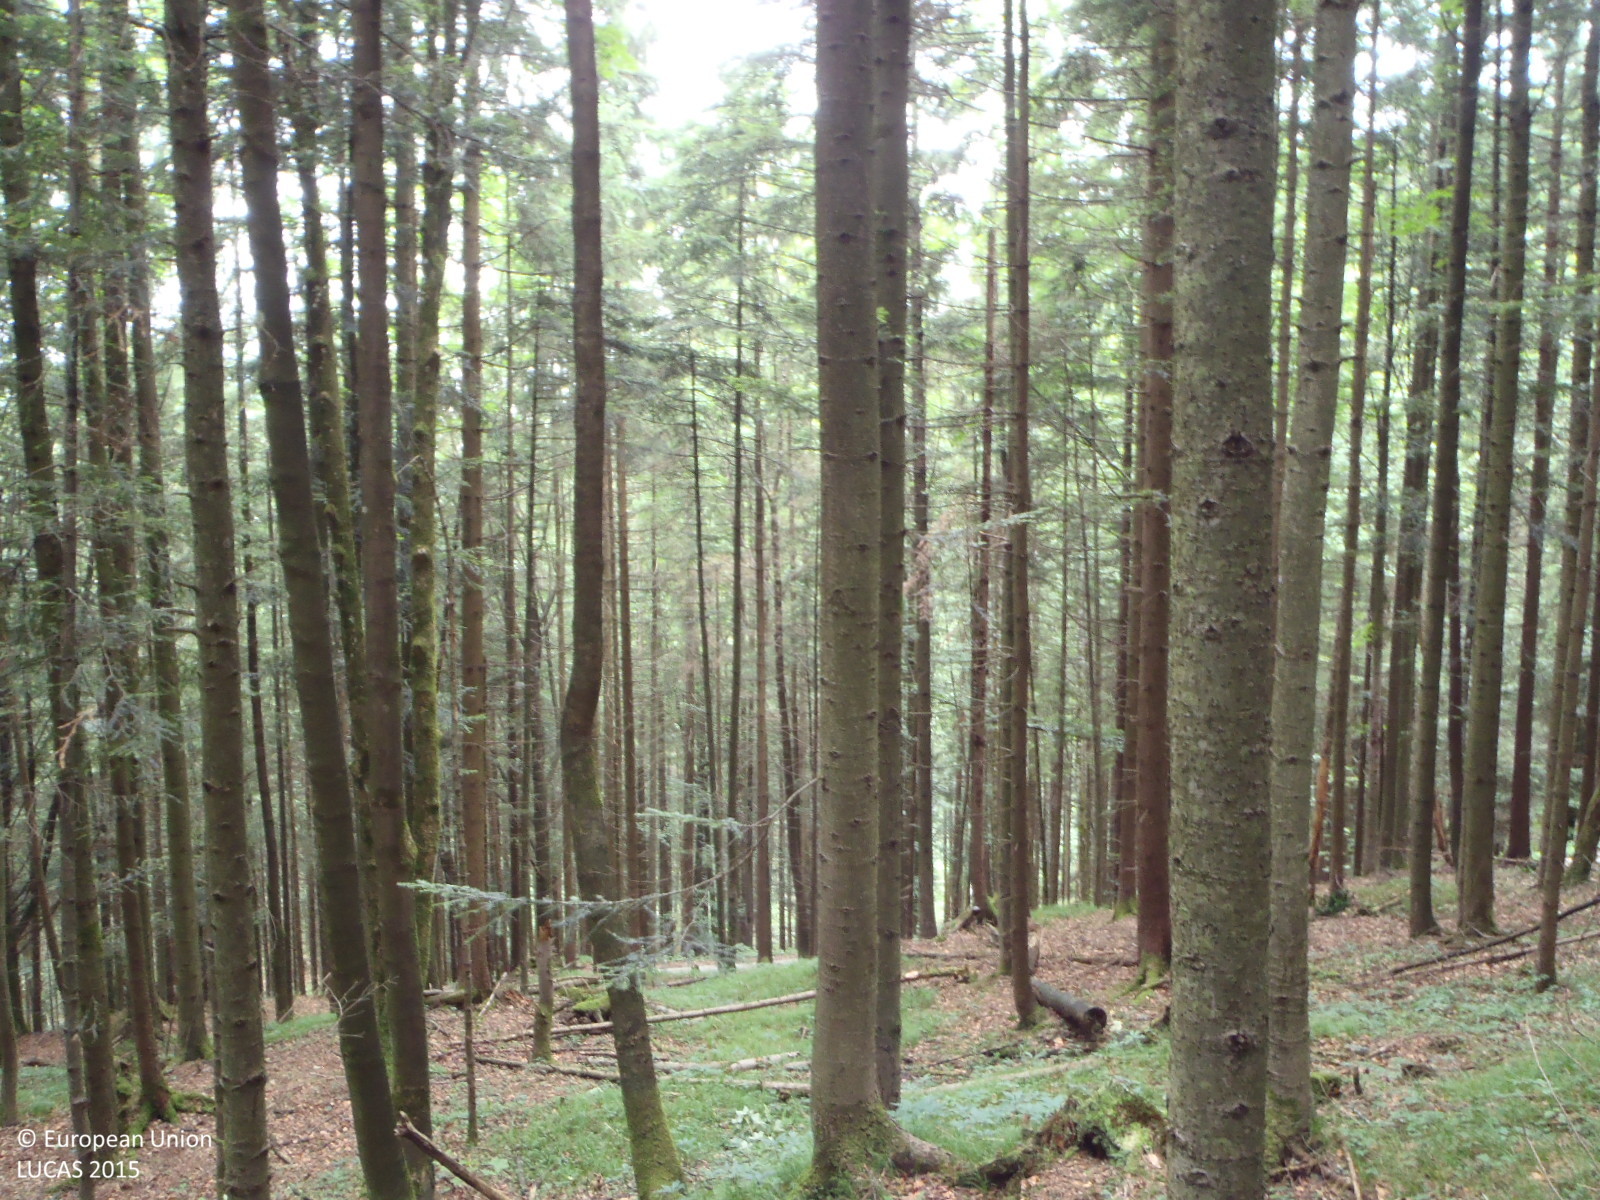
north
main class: Woodland
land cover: Spruce dominated coniferous woodland
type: alpine coniferous forest
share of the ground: > 75 %
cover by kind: coniferous forest trees 80 %, broadleaved forest trees 10 %, herbaceous plants 10 %
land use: Forestry
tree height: > 5 m
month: July
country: AT
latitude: 47.5896
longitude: 12.1926
